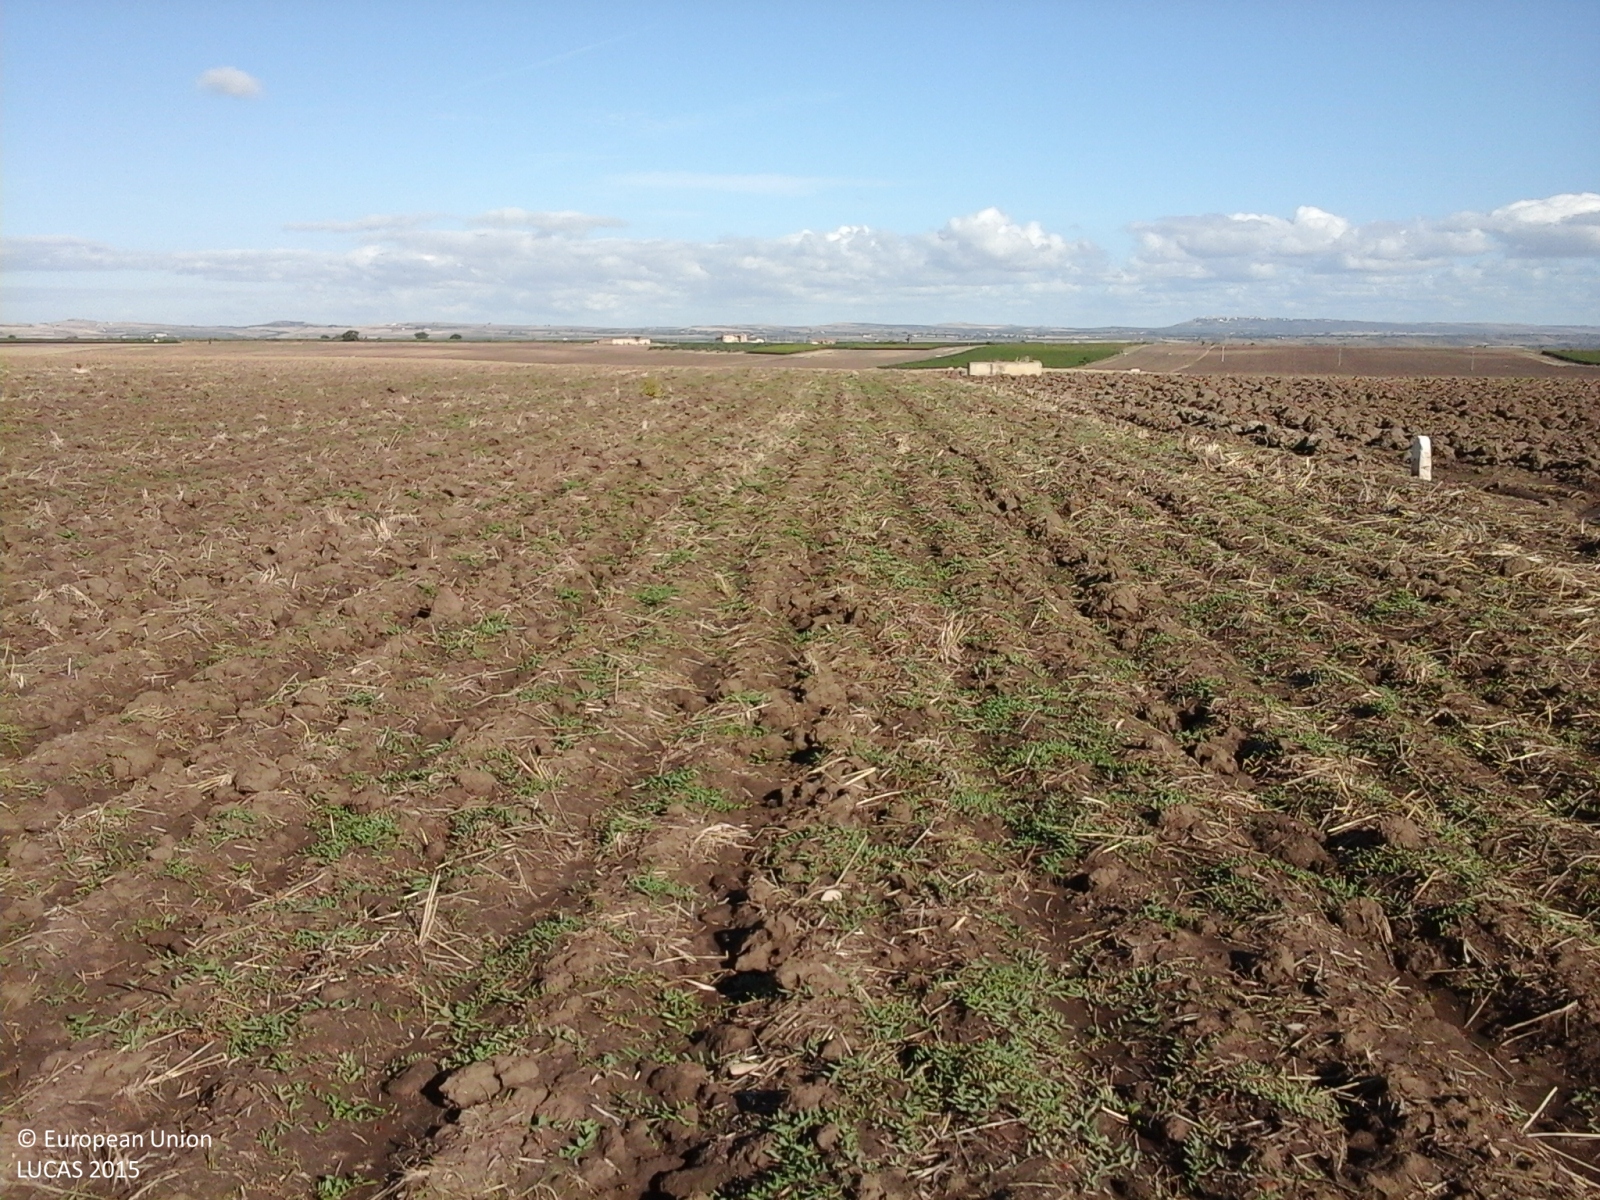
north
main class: Cropland
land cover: Dry pulses
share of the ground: > 75 %
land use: Agriculture (excluding fallow land and kitchen gardens)
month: September
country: IT
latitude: 41.6705
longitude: 15.1840
